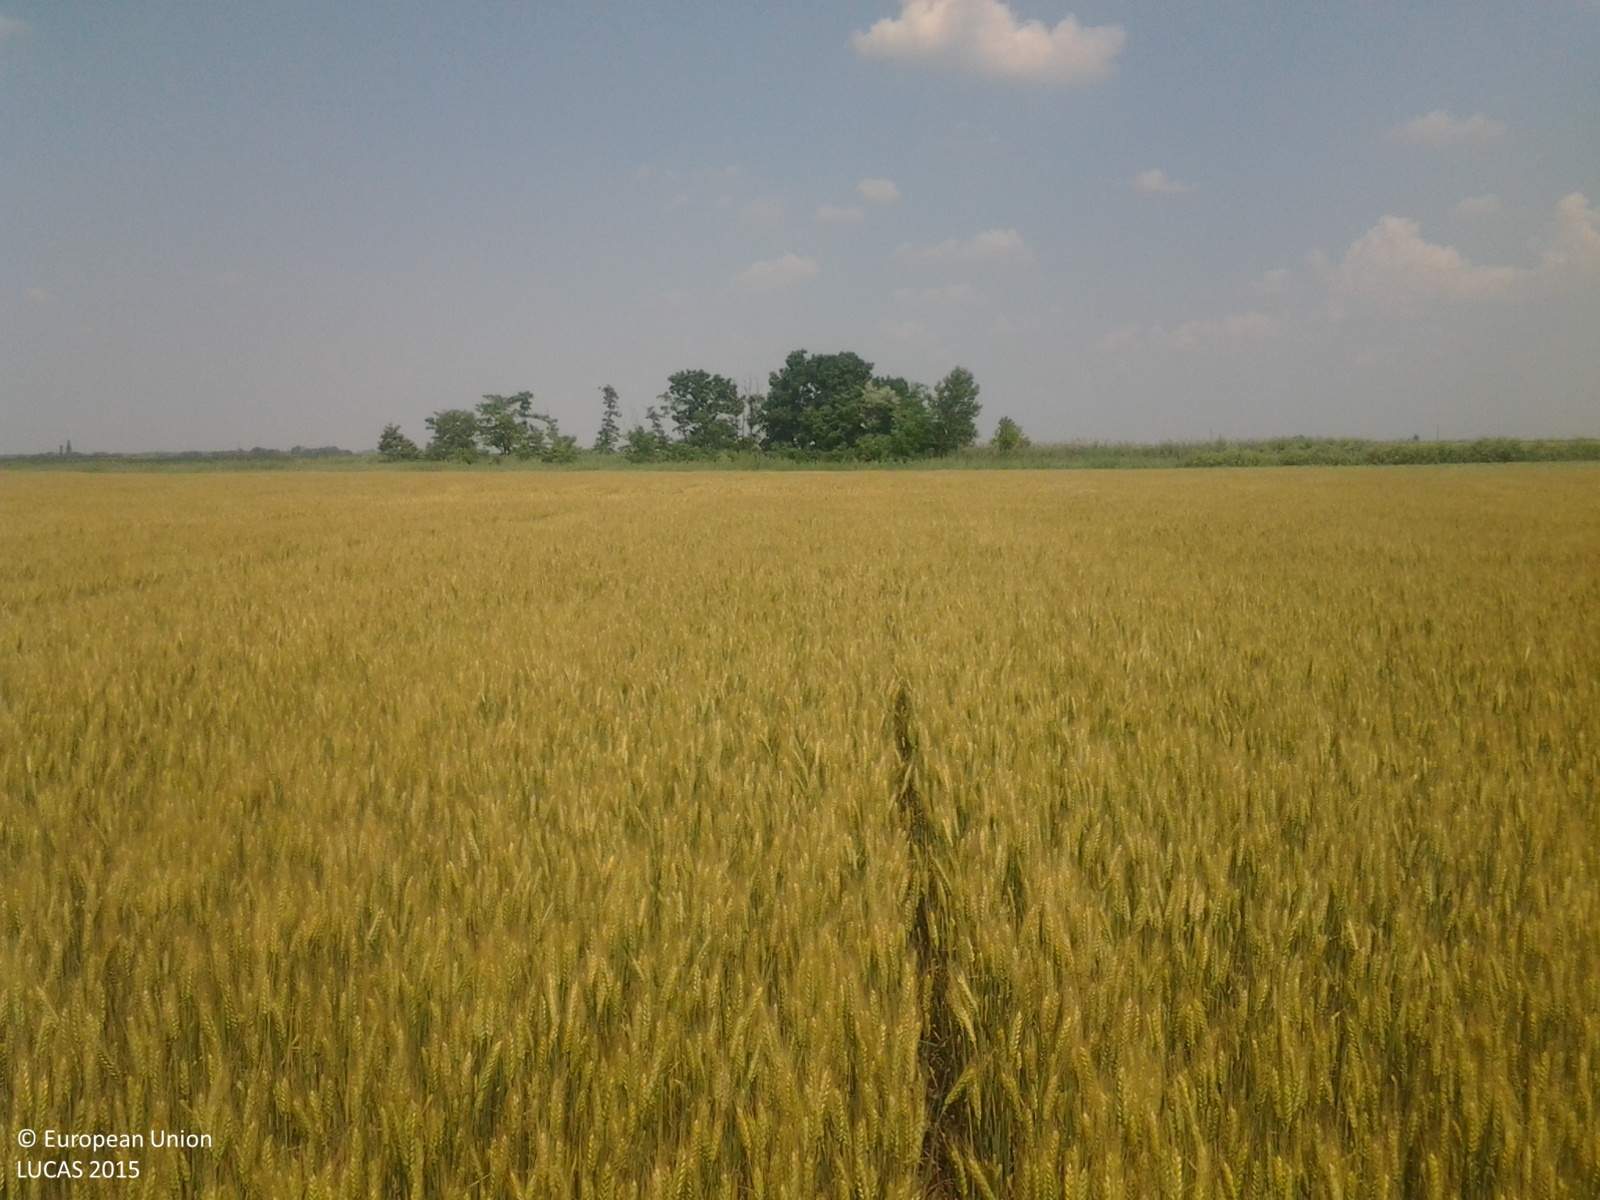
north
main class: Cropland
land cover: Triticale
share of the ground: > 75 %
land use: Agriculture (excluding fallow land and kitchen gardens)
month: June
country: HU
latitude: 46.6380
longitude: 19.0412
